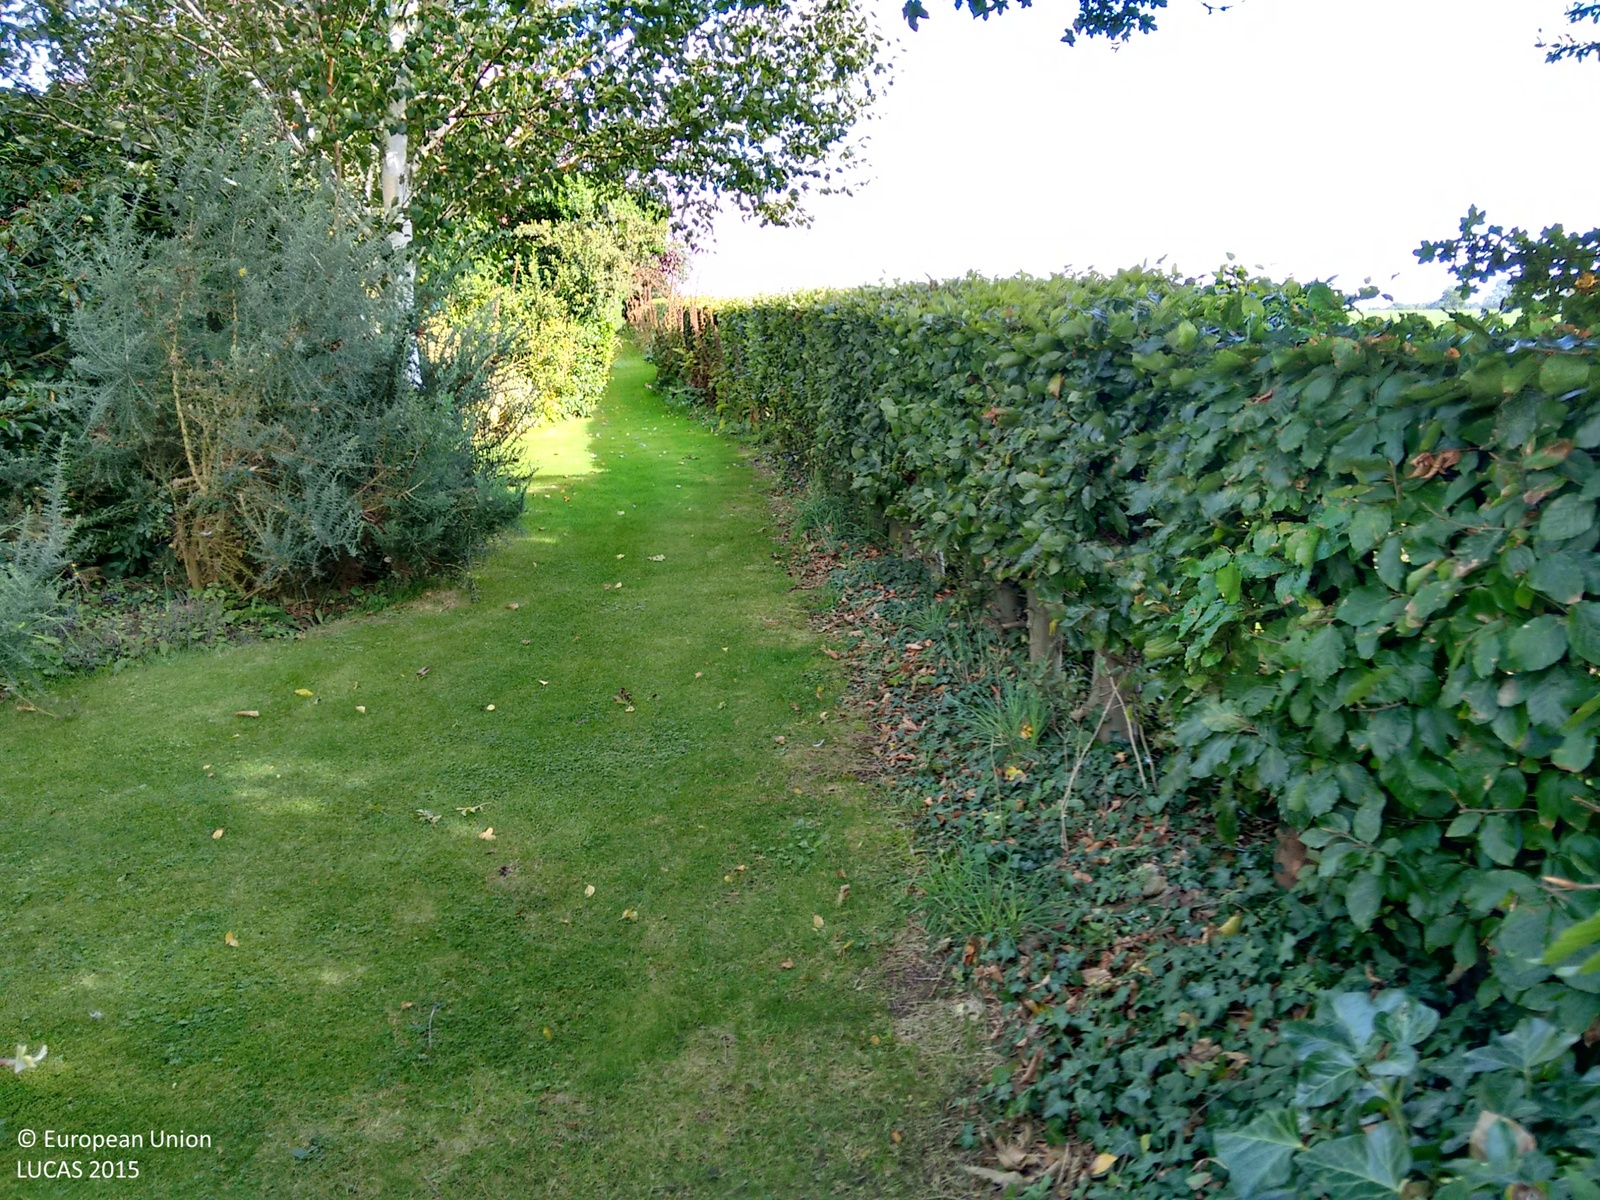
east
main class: Grassland
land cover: Grassland with sparse tree/shrub cover
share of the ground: > 75 %
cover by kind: herbaceous plants 95 %, broadleaved forest trees 5 %
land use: Residential
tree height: > 5 m
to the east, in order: Grassland with sparse tree/shrub cover; Managed hedges; Grass margins; Sugar beet
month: September
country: GB
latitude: 52.8506
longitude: 1.2628
